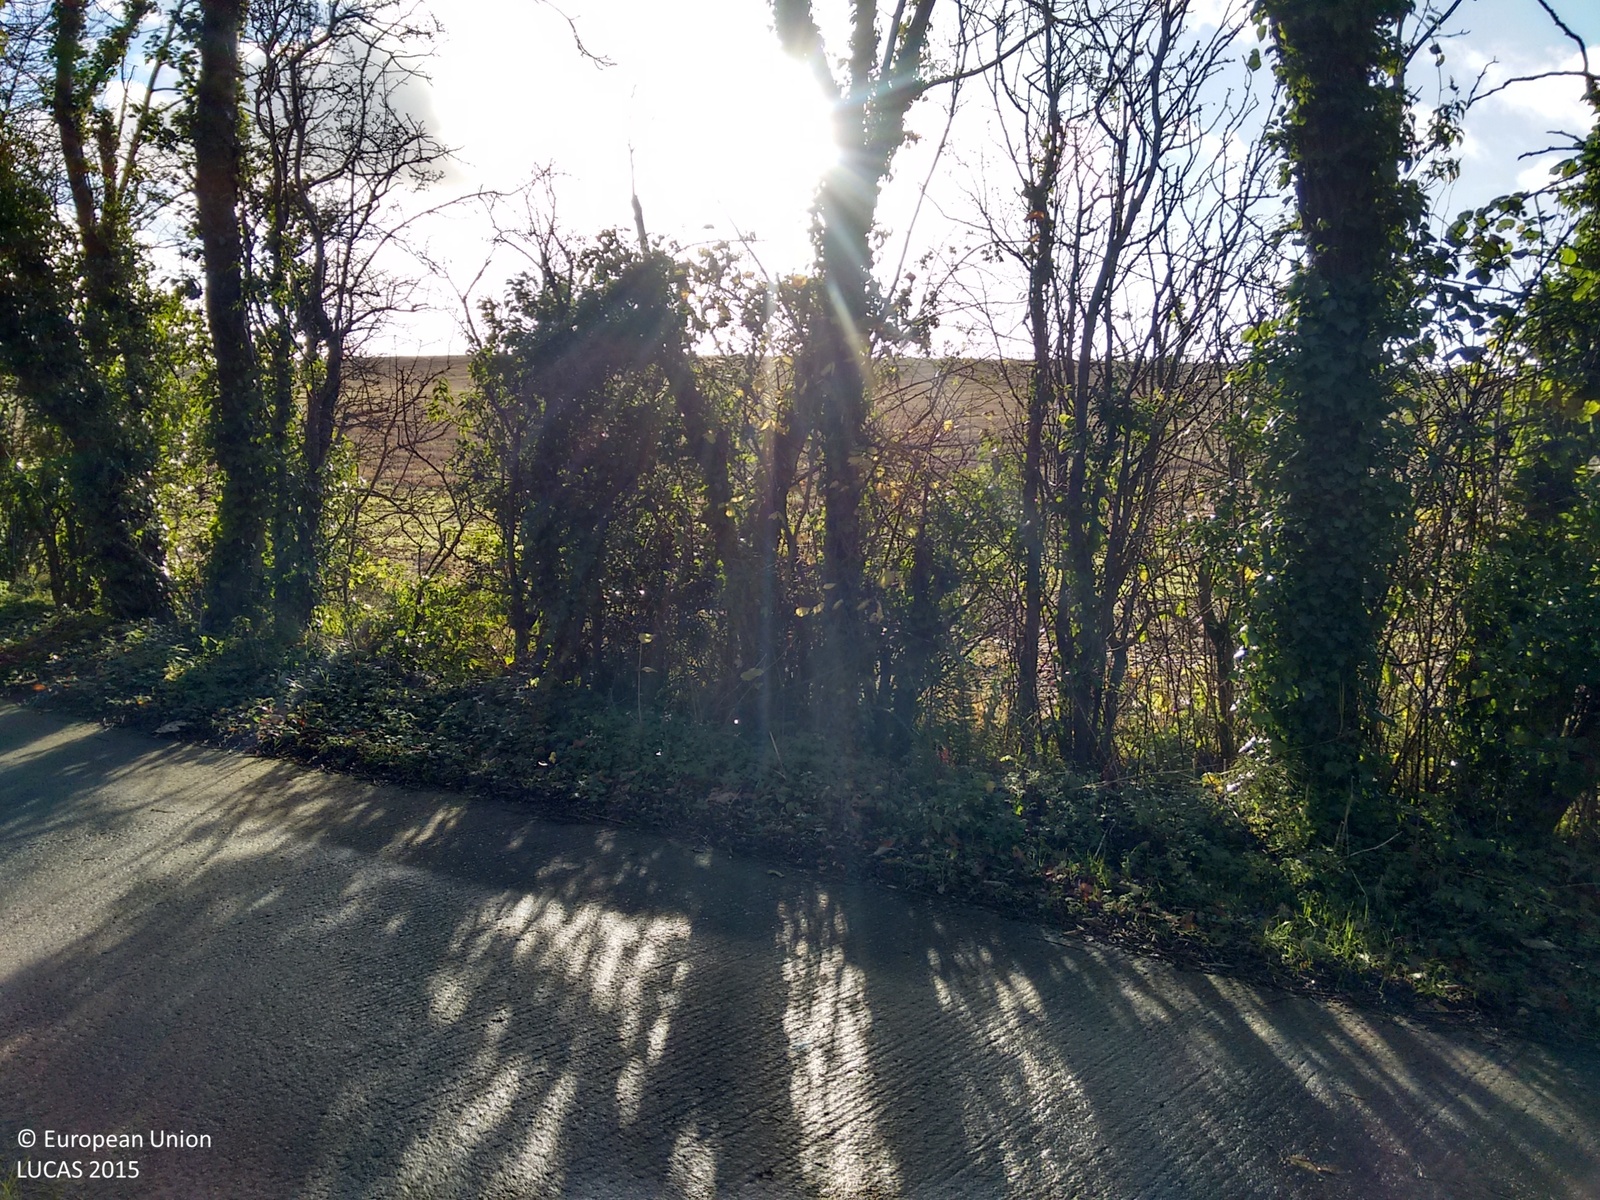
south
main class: Woodland
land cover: Broadleaved woodland
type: exotic forest
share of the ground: > 75 %
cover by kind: broadleaved forest trees 90 %, shrubs 5 %, herbaceous plants 5 %
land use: Semi-natural and natural areas not in use
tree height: > 5 m
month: November
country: GB
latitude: 54.4657
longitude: -5.5099
